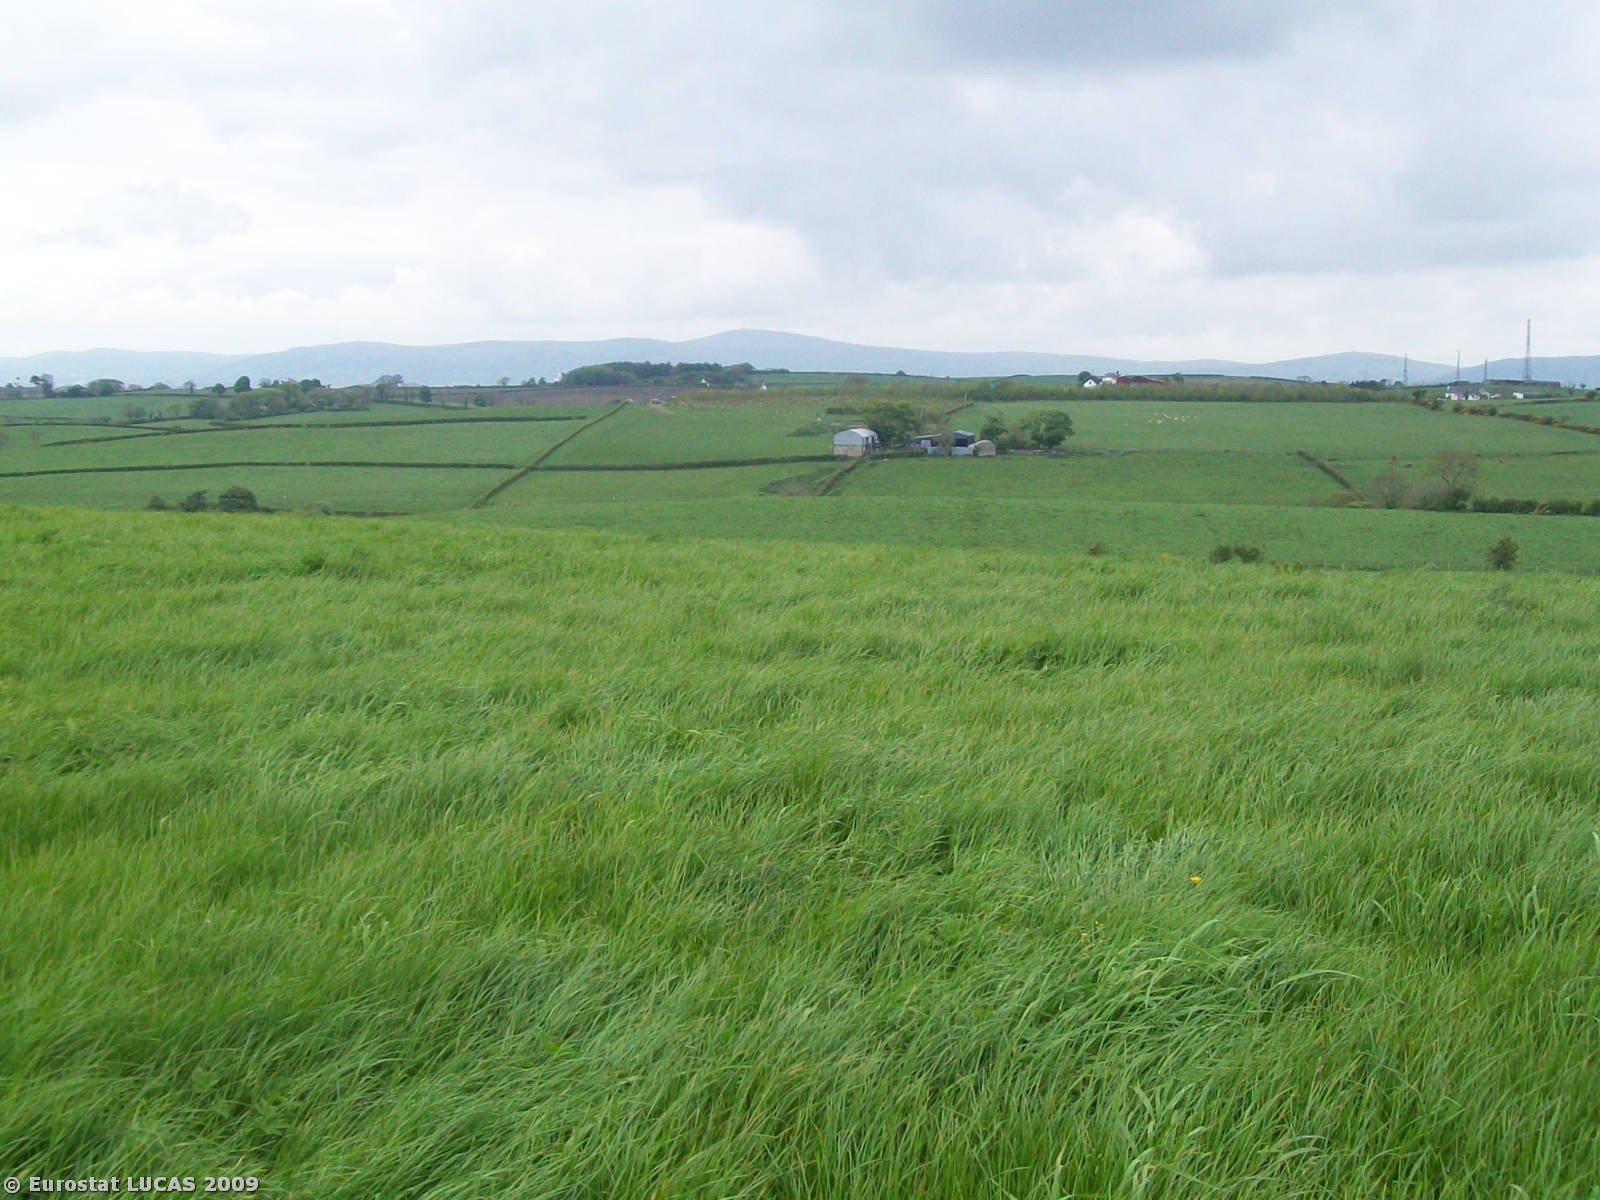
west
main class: Grassland
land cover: Grassland without tree/shrub cover
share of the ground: > 75 %
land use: Agriculture (excluding fallow land and kitchen gardens)
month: May
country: GB
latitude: 54.6134
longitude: -5.7894
